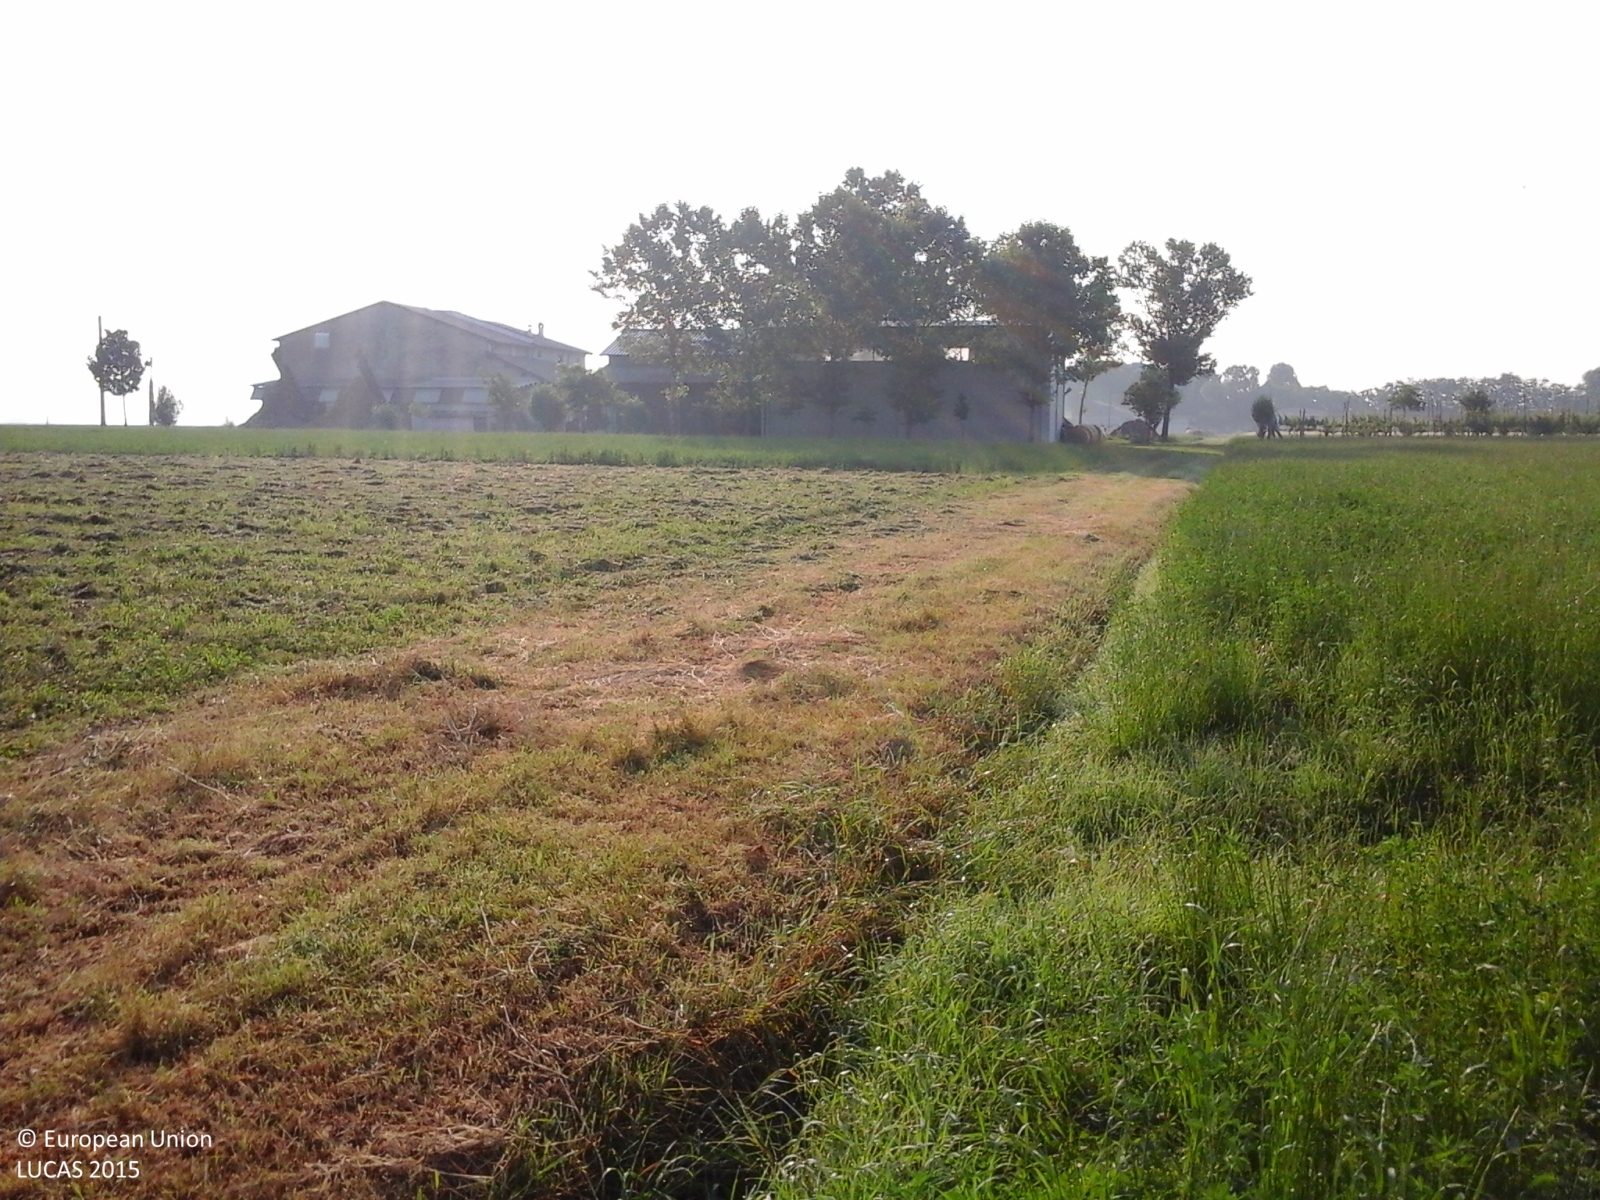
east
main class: Cropland
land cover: Lucerne
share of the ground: > 75 %
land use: Agriculture (excluding fallow land and kitchen gardens)
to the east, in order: Lucerne; Ditches and canals; Tracks; Lucerne; Ditches and canals; Lucerne; Artificial constructions in urban areas; Lucerne; Ditches and canals; Lucerne; Ditches and canals; Lucerne
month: June
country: IT
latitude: 44.9635
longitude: 10.1645
